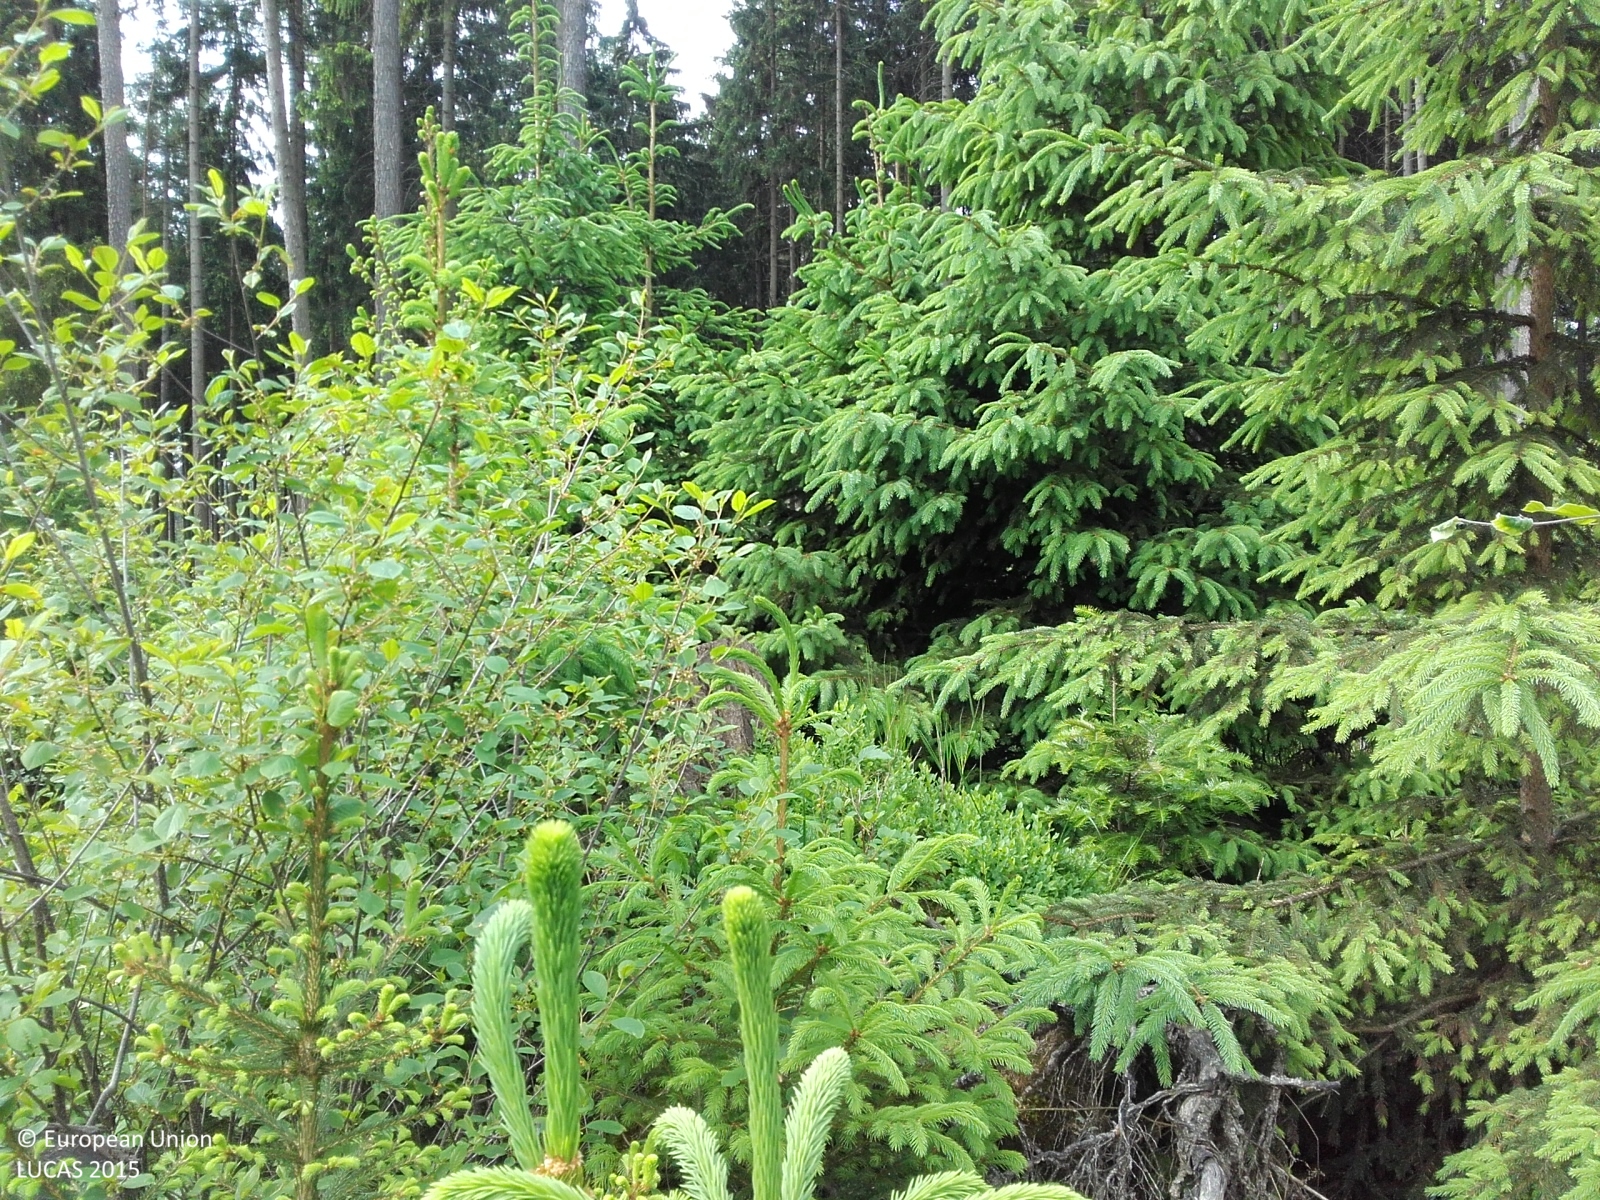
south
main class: Woodland
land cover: Spruce dominated mixed woodland
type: hemiboreal forest and nemoral coniferous forest and mixed broadleaved-coniferous forest
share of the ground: > 75 %
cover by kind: coniferous forest trees 60 %, broadleaved forest trees 20 %, shrubs 10 %, herbaceous plants 10 %
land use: Forestry
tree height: > 5 m
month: June
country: CZ
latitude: 49.6206
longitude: 17.6399
